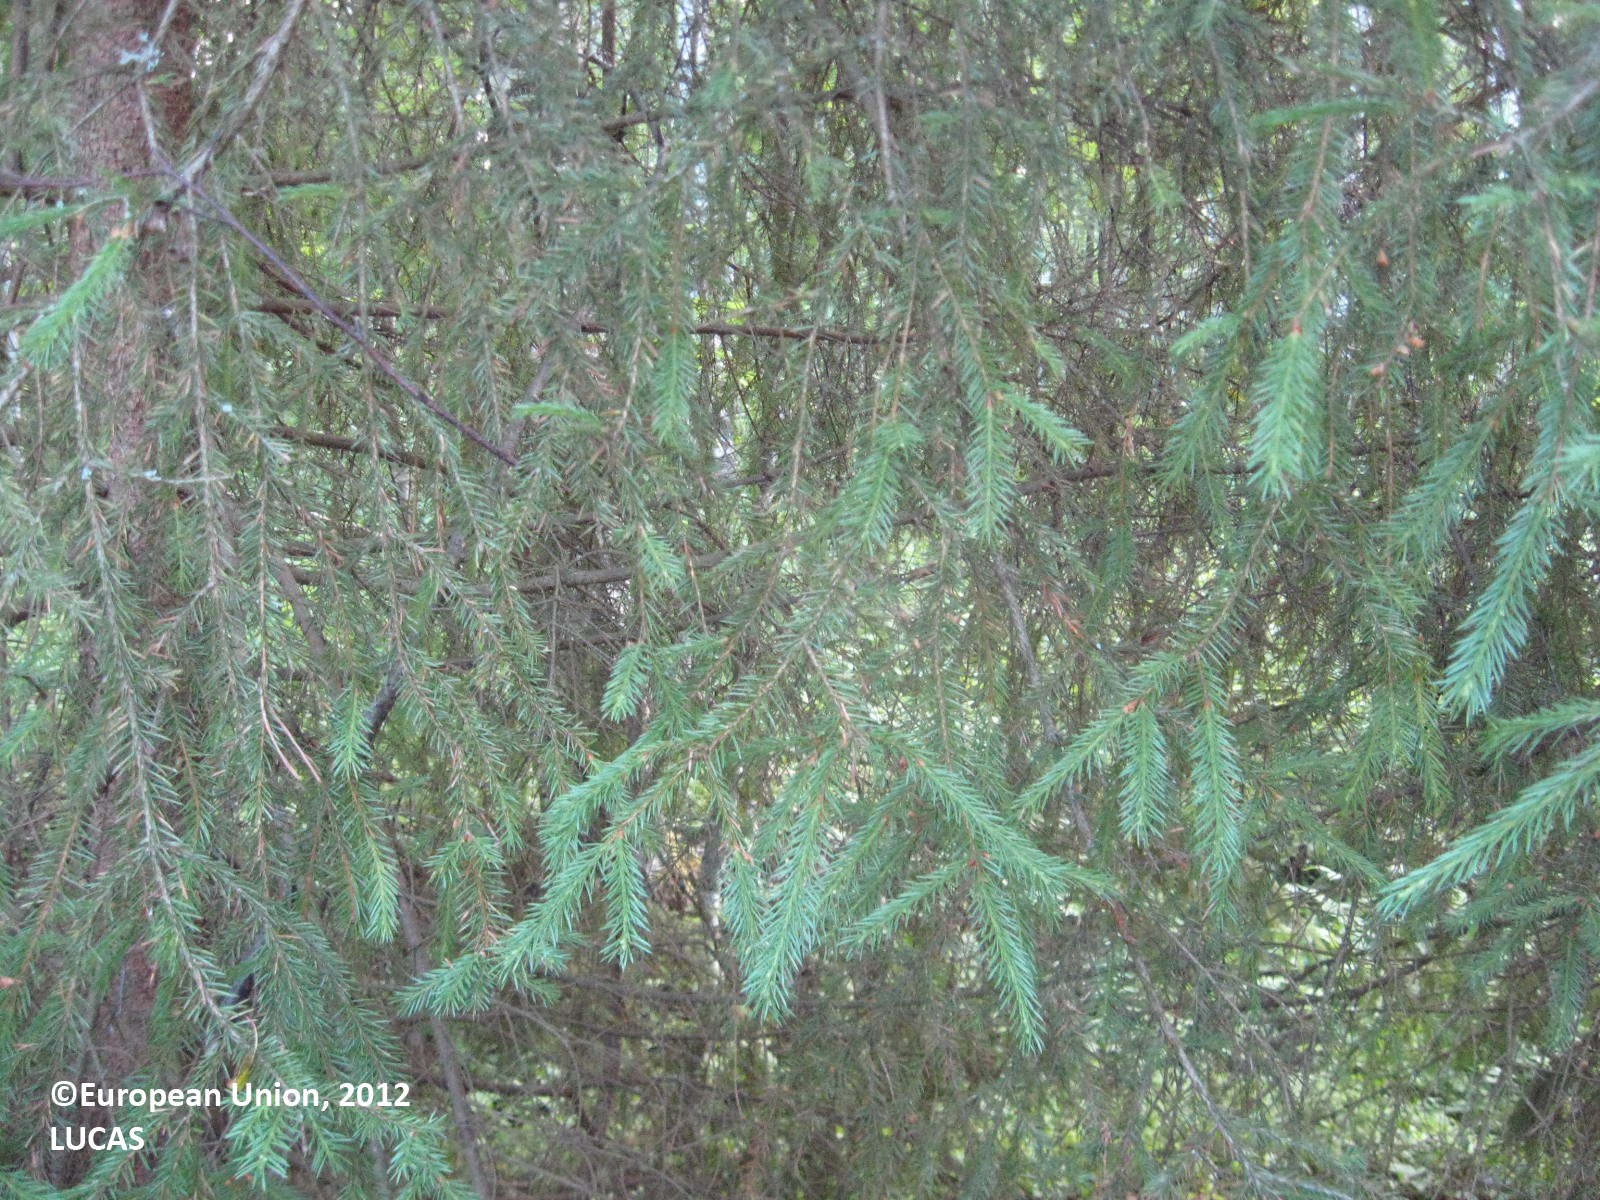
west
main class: Woodland
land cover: Other mixed woodland
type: boreal forest
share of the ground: > 75 %
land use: Forestry
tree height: > 5 m
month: June
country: FI
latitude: 62.9067
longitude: 22.7900
